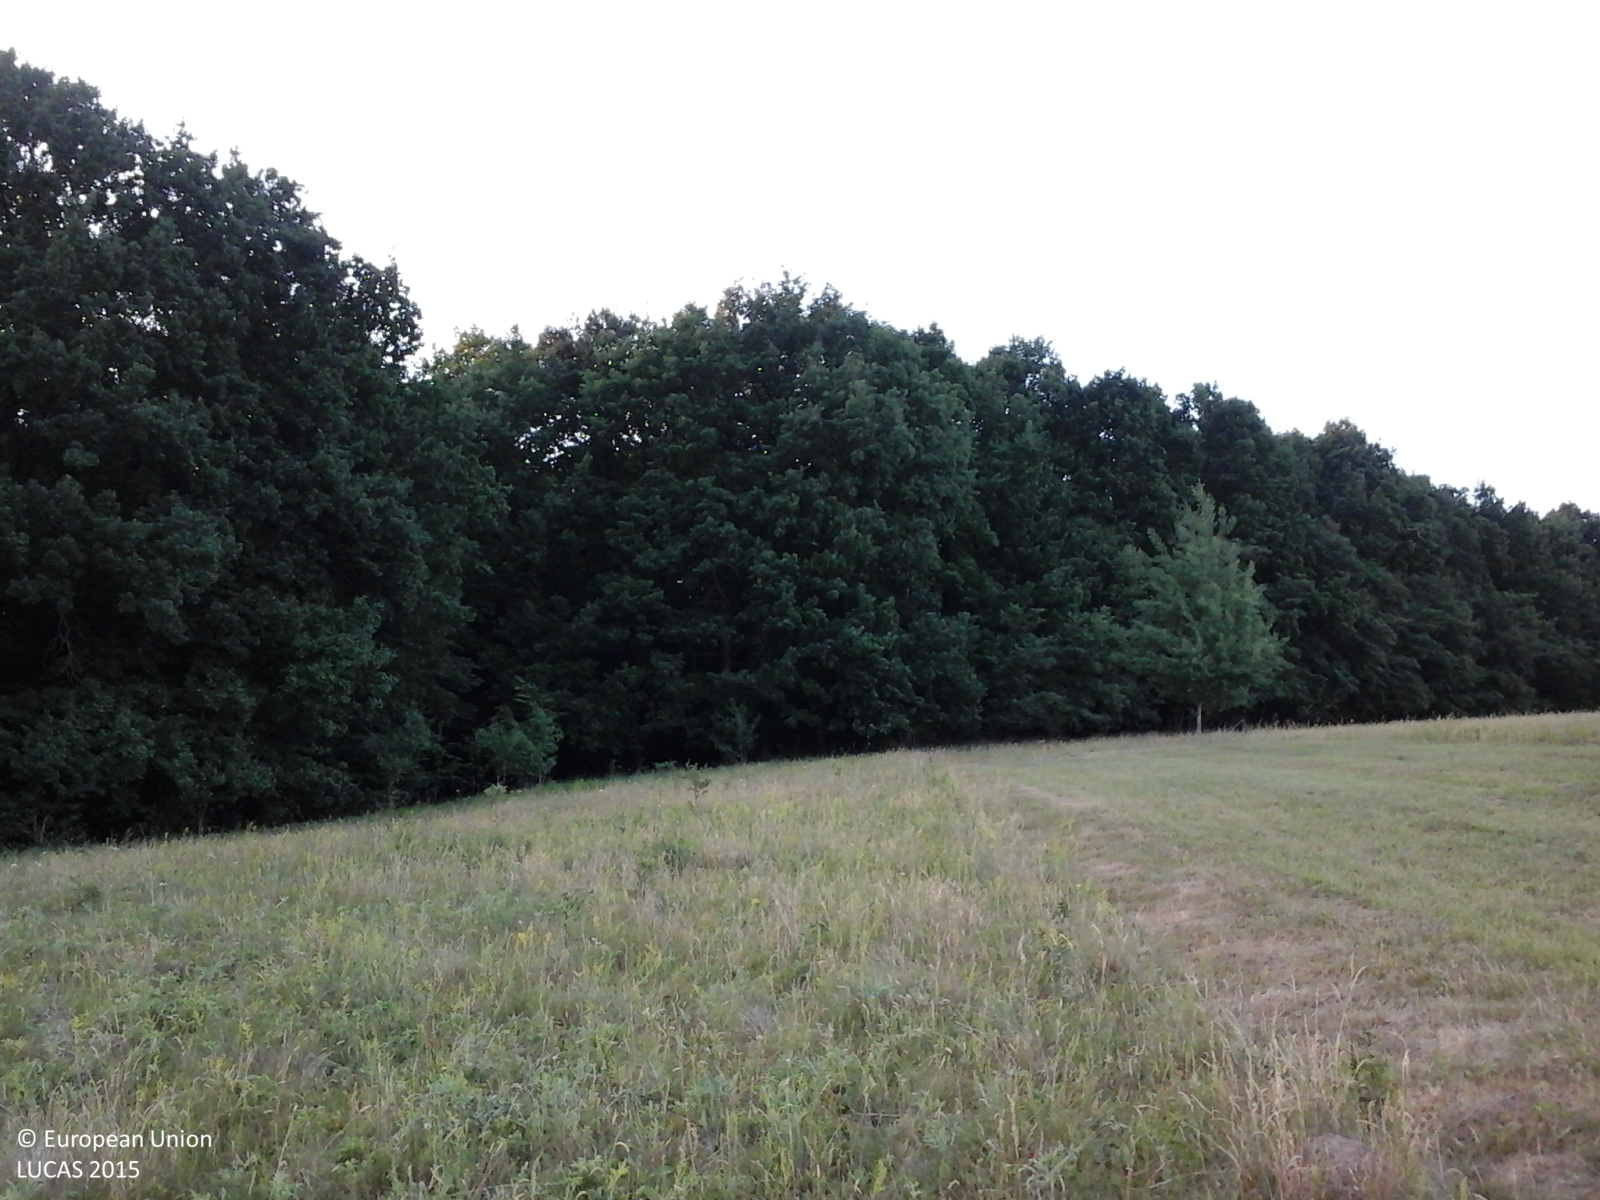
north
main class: Grassland
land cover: Grassland with sparse tree/shrub cover
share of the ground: > 75 %
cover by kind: herbaceous plants 90 %, broadleaved forest trees 5 %, shrubs 5 %
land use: Agriculture (excluding fallow land and kitchen gardens)
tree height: < 5 m
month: June
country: RO
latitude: 47.4297
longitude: 26.4877
